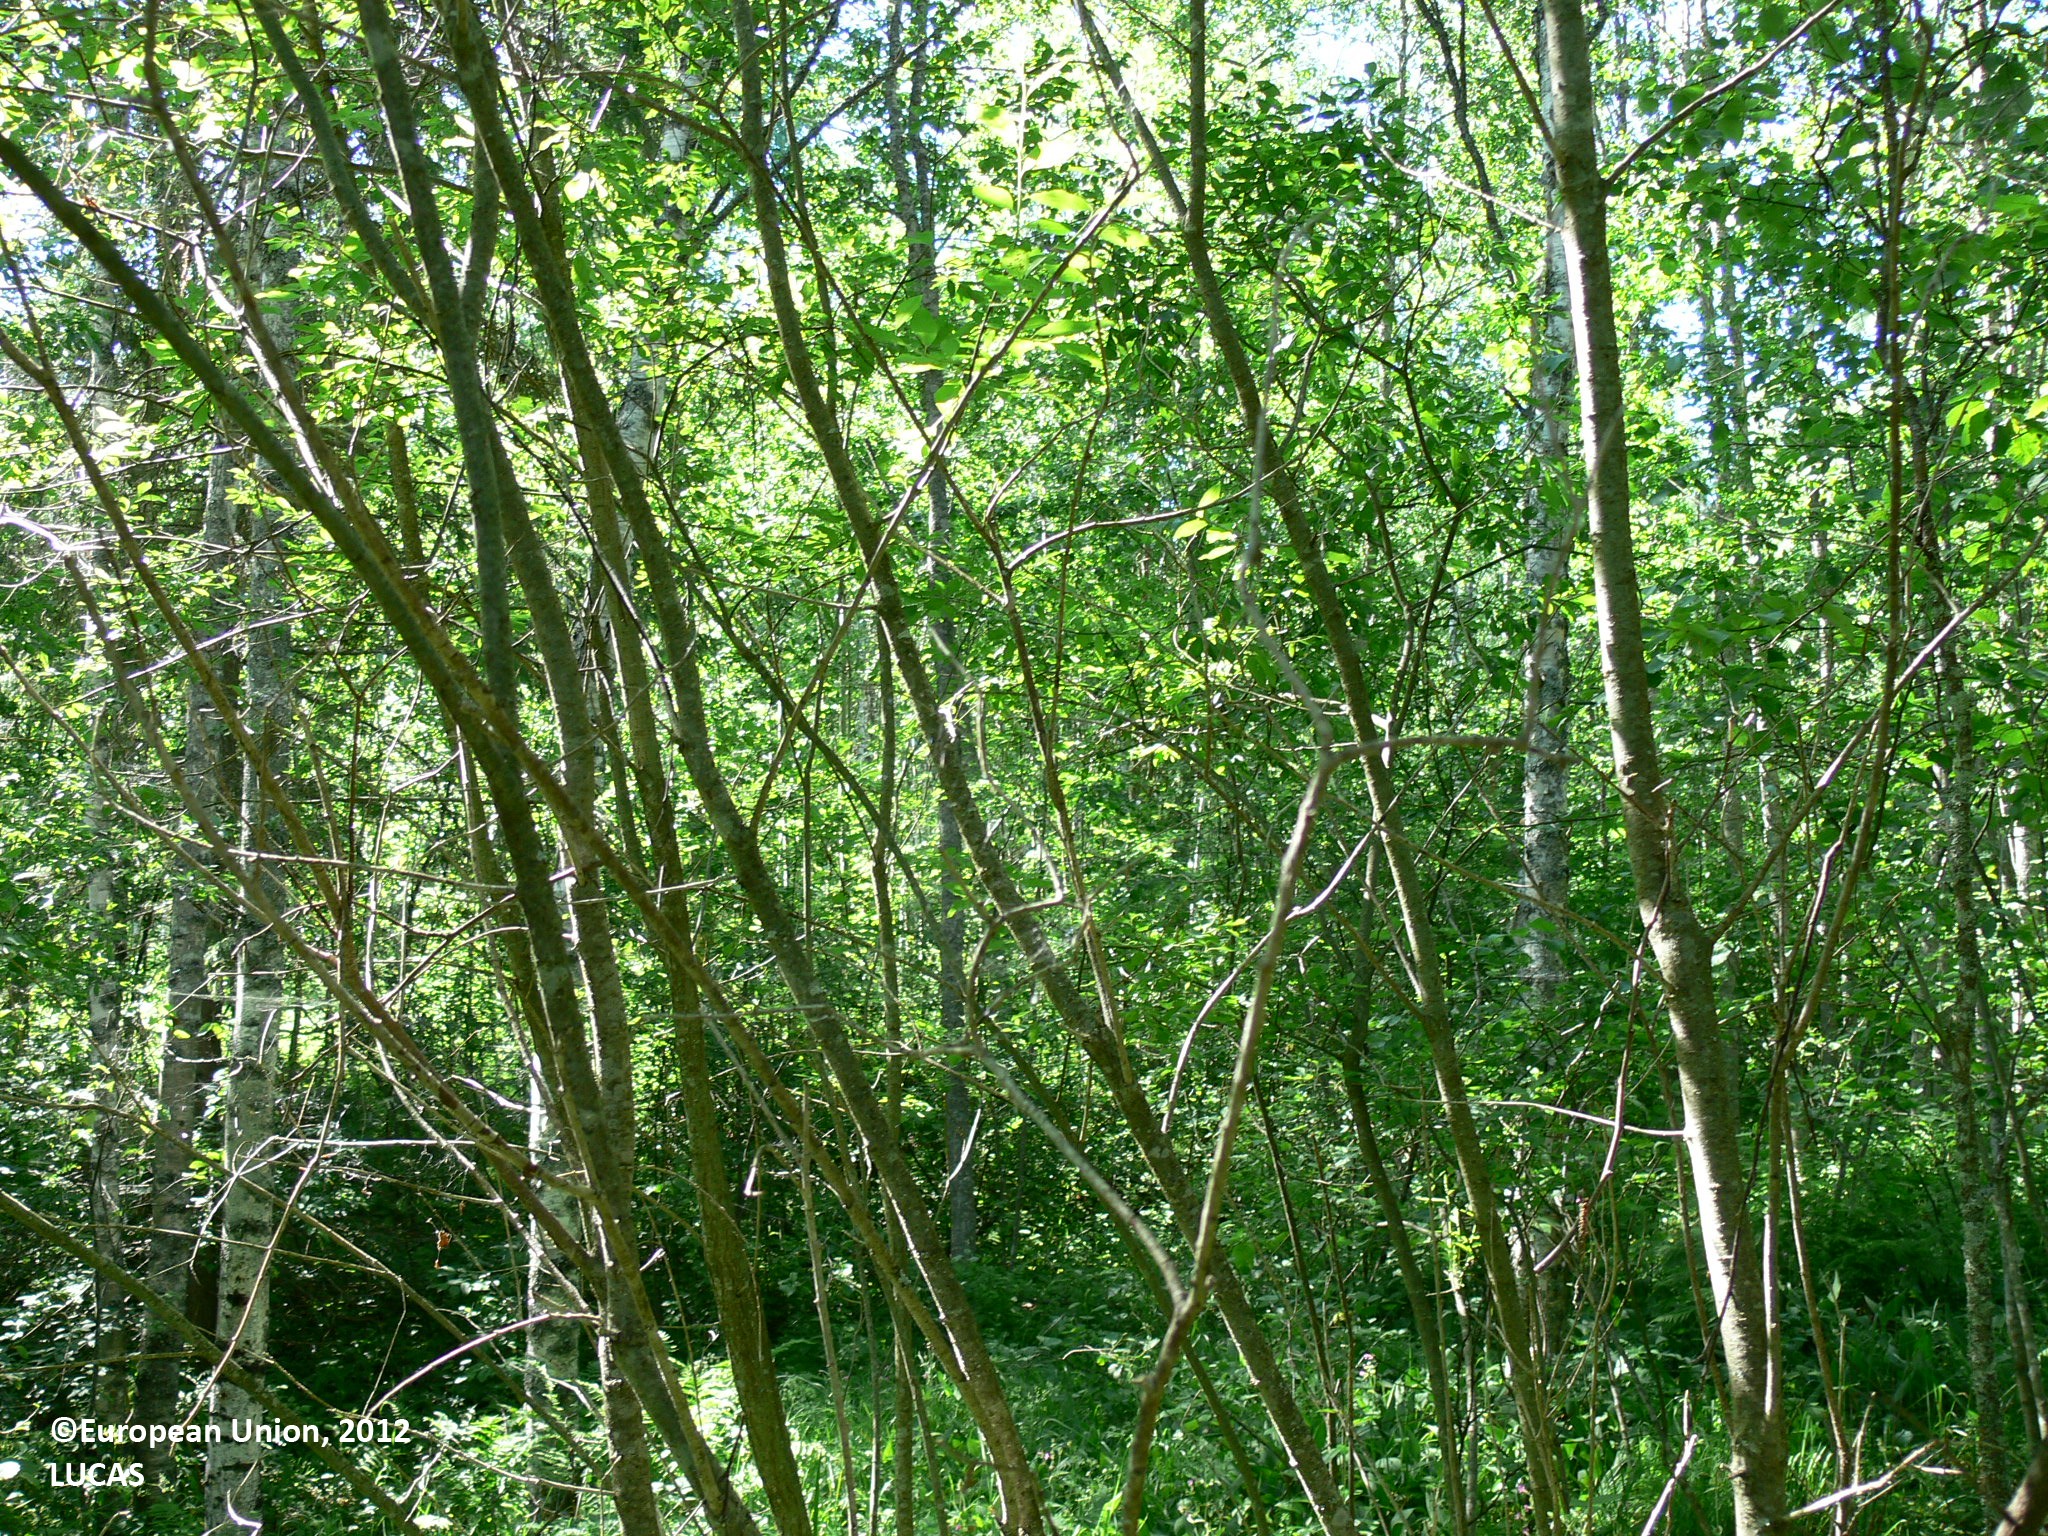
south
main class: Woodland
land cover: Broadleaved woodland
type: boreal forest
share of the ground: > 75 %
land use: Forestry
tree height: > 5 m
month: July
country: FI
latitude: 62.9805
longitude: 29.9226
